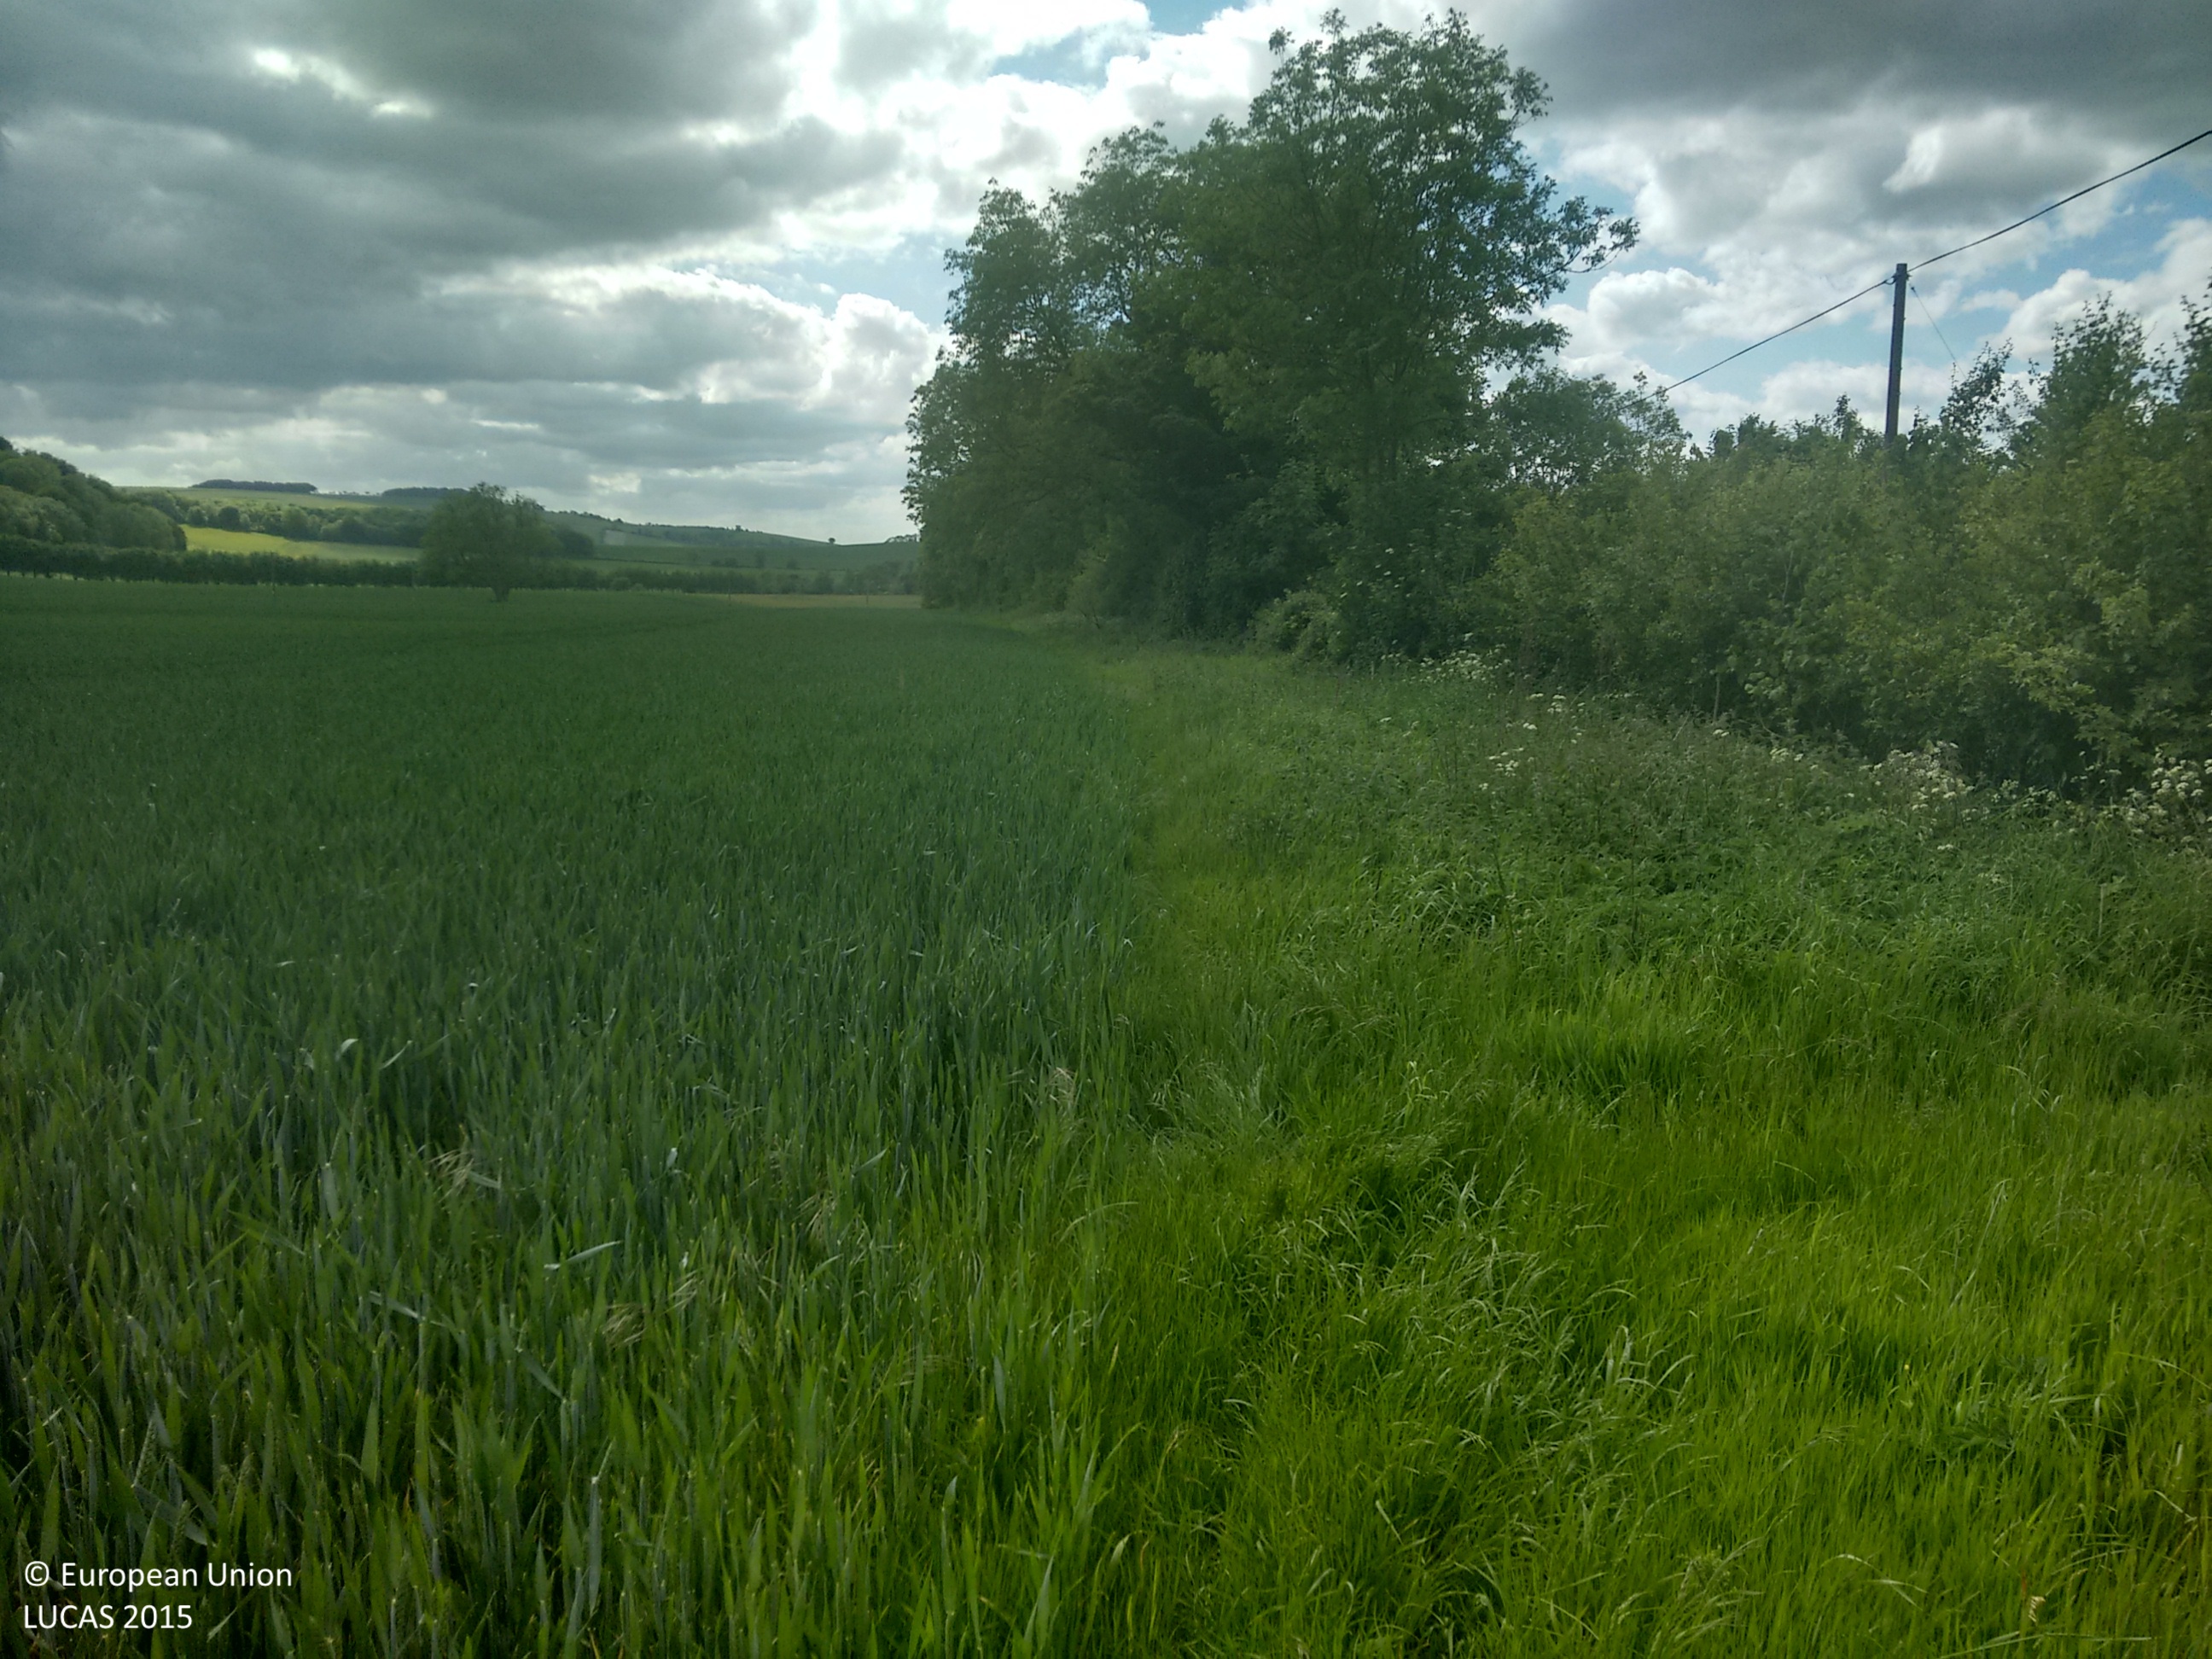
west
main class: Cropland
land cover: Common wheat
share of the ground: > 75 %
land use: Agriculture (excluding fallow land and kitchen gardens)
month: June
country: GB
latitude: 50.9920
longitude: -2.0988
